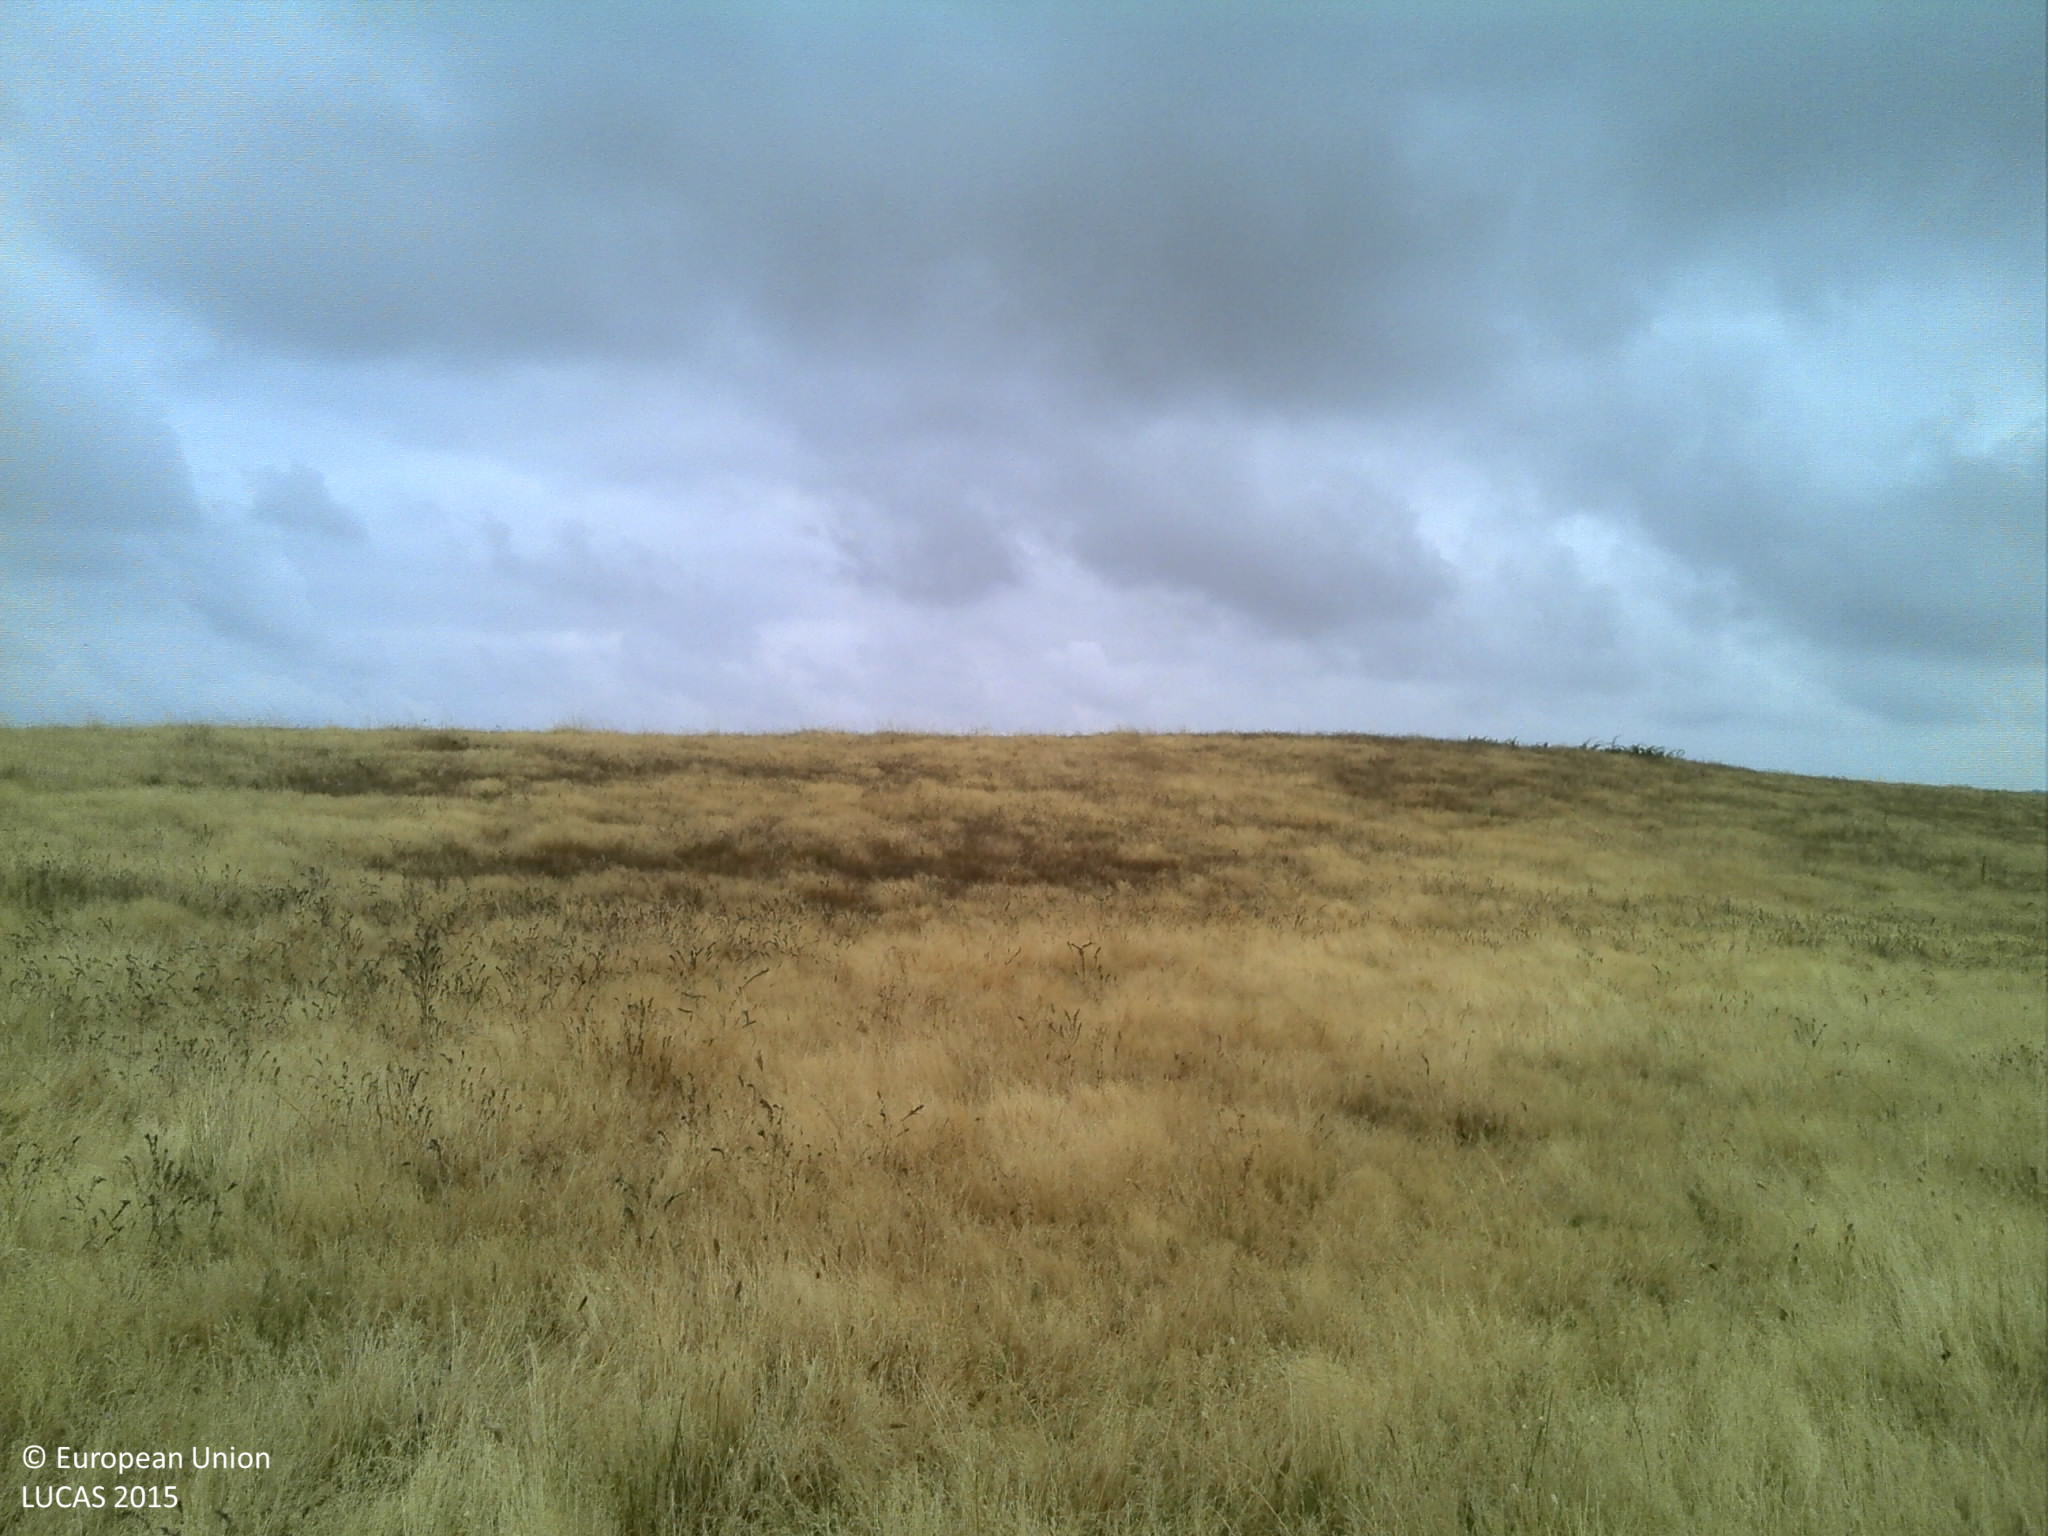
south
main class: Grassland
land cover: Grassland without tree/shrub cover
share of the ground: > 75 %
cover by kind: herbaceous plants 90 %, unconsolidated bare surface 10 %
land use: Agriculture (excluding fallow land and kitchen gardens)
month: June
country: PT
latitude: 38.3702
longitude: -7.9728
